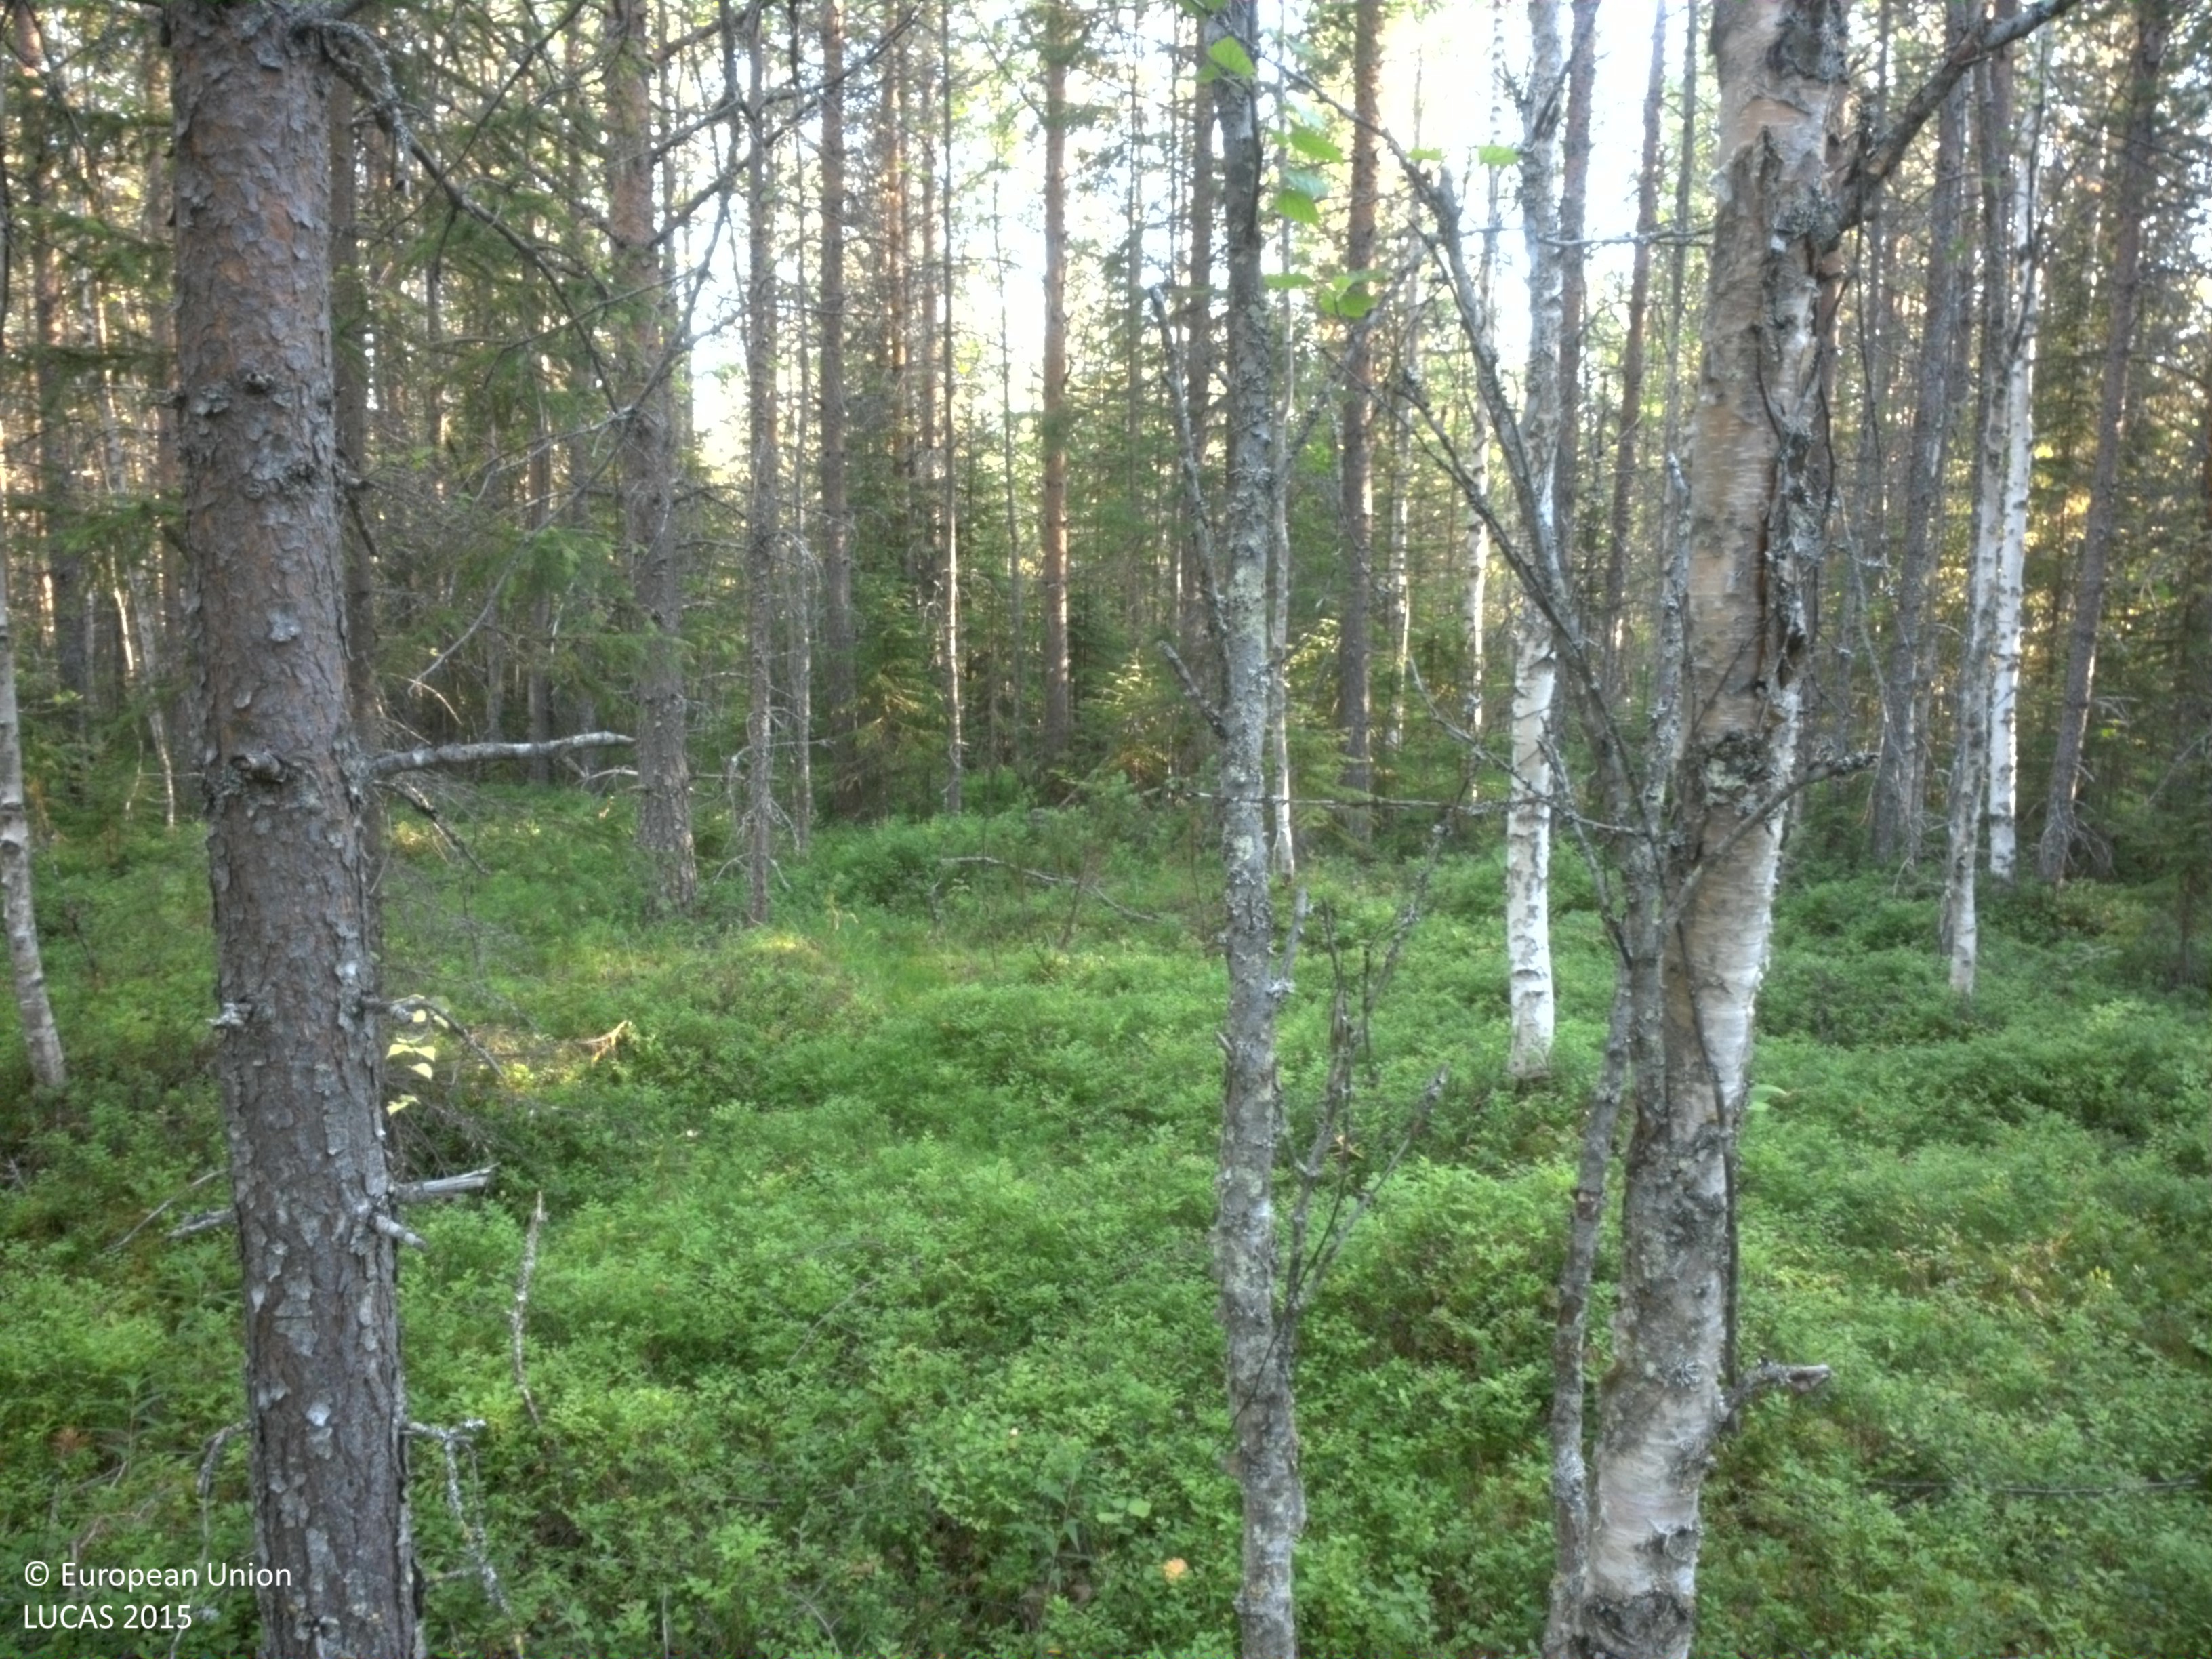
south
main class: Woodland
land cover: Pine dominated mixed woodland
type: boreal forest
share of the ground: 50 - 75 %
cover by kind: coniferous forest trees 45 %, shrubs 35 %, broadleaved forest trees 15 %, lichens and mosses 5 %
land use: Forestry
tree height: > 5 m
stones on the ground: 25 - 50 %
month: August
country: SE
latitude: 64.6500
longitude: 19.0327
